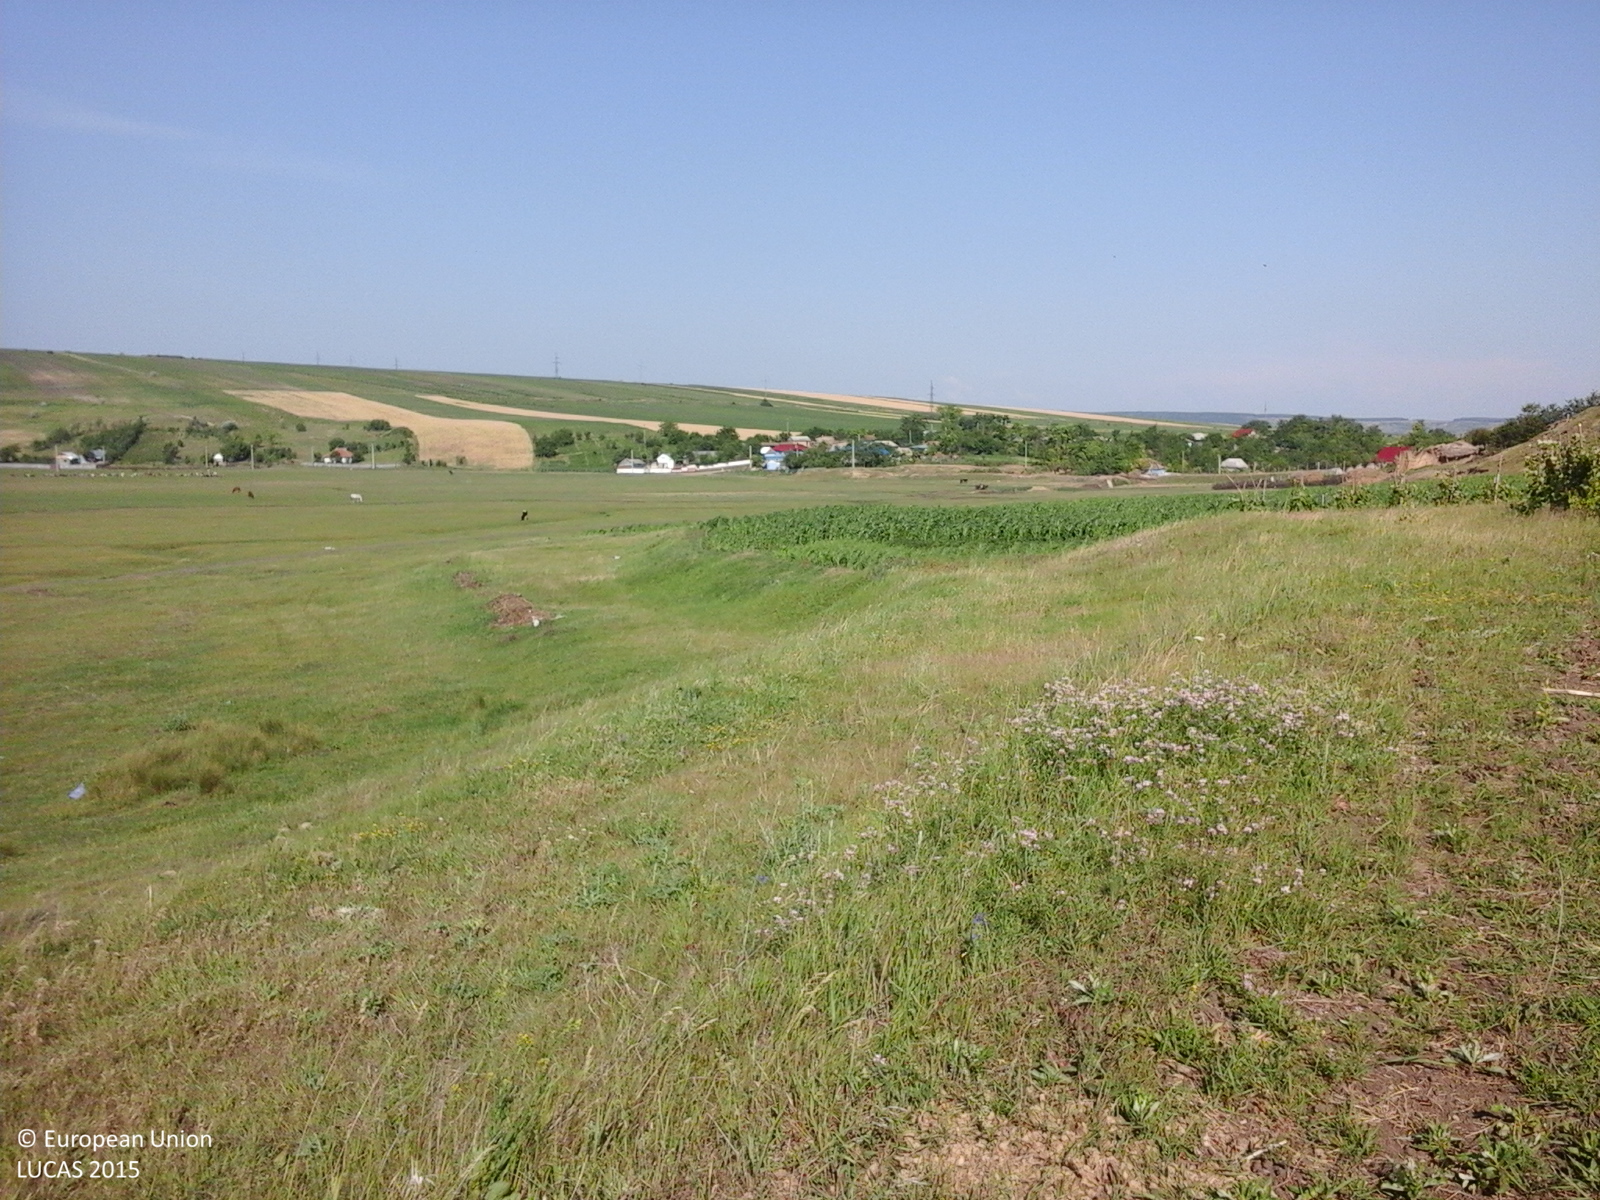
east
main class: Grassland
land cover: Grassland without tree/shrub cover
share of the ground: > 75 %
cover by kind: herbaceous plants 100 %
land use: Agriculture (excluding fallow land and kitchen gardens)
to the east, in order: Grassland without tree/shrub cover; Maize; Grassland without tree/shrub cover; Tracks; Grassland without tree/shrub cover; Ditches and canals; Grassland without tree/shrub cover
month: June
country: RO
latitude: 46.8225
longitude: 27.7511
